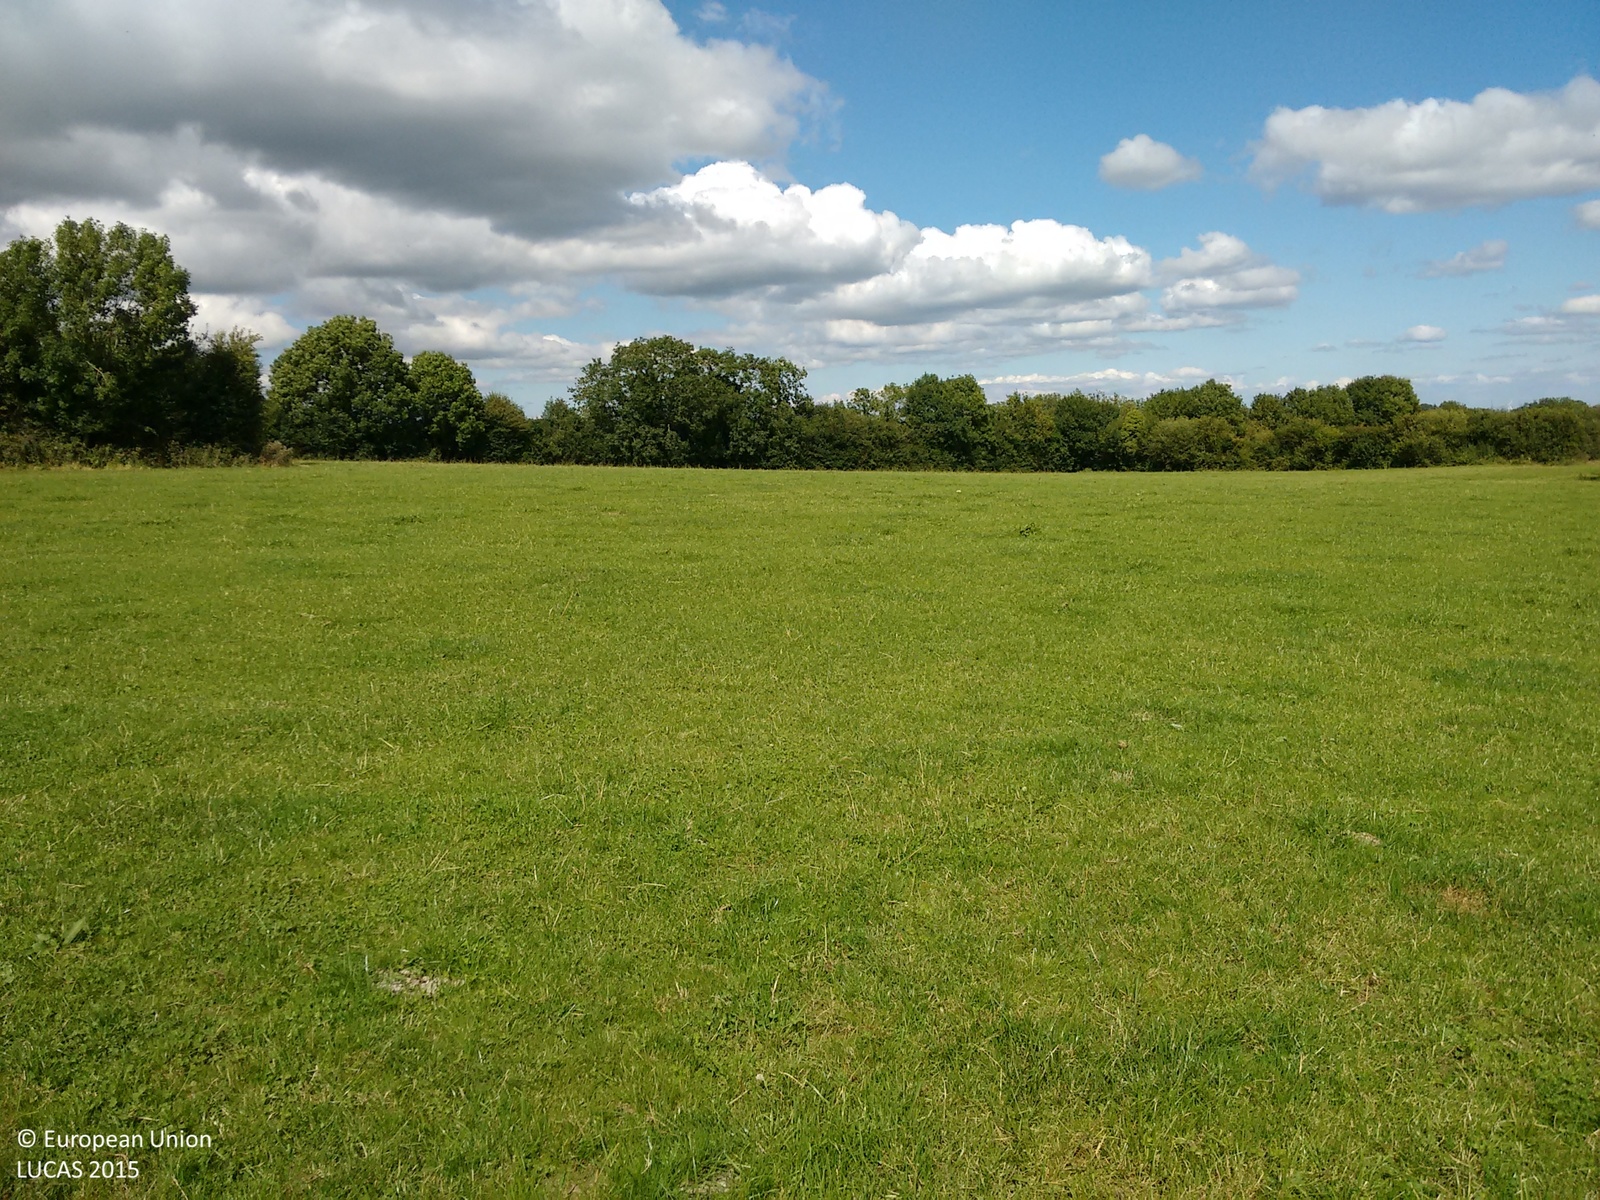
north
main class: Grassland
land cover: Grassland without tree/shrub cover
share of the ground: > 75 %
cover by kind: herbaceous plants 100 %
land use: Agriculture (excluding fallow land and kitchen gardens)
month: August
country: IE
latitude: 52.8906
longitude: -7.8424
